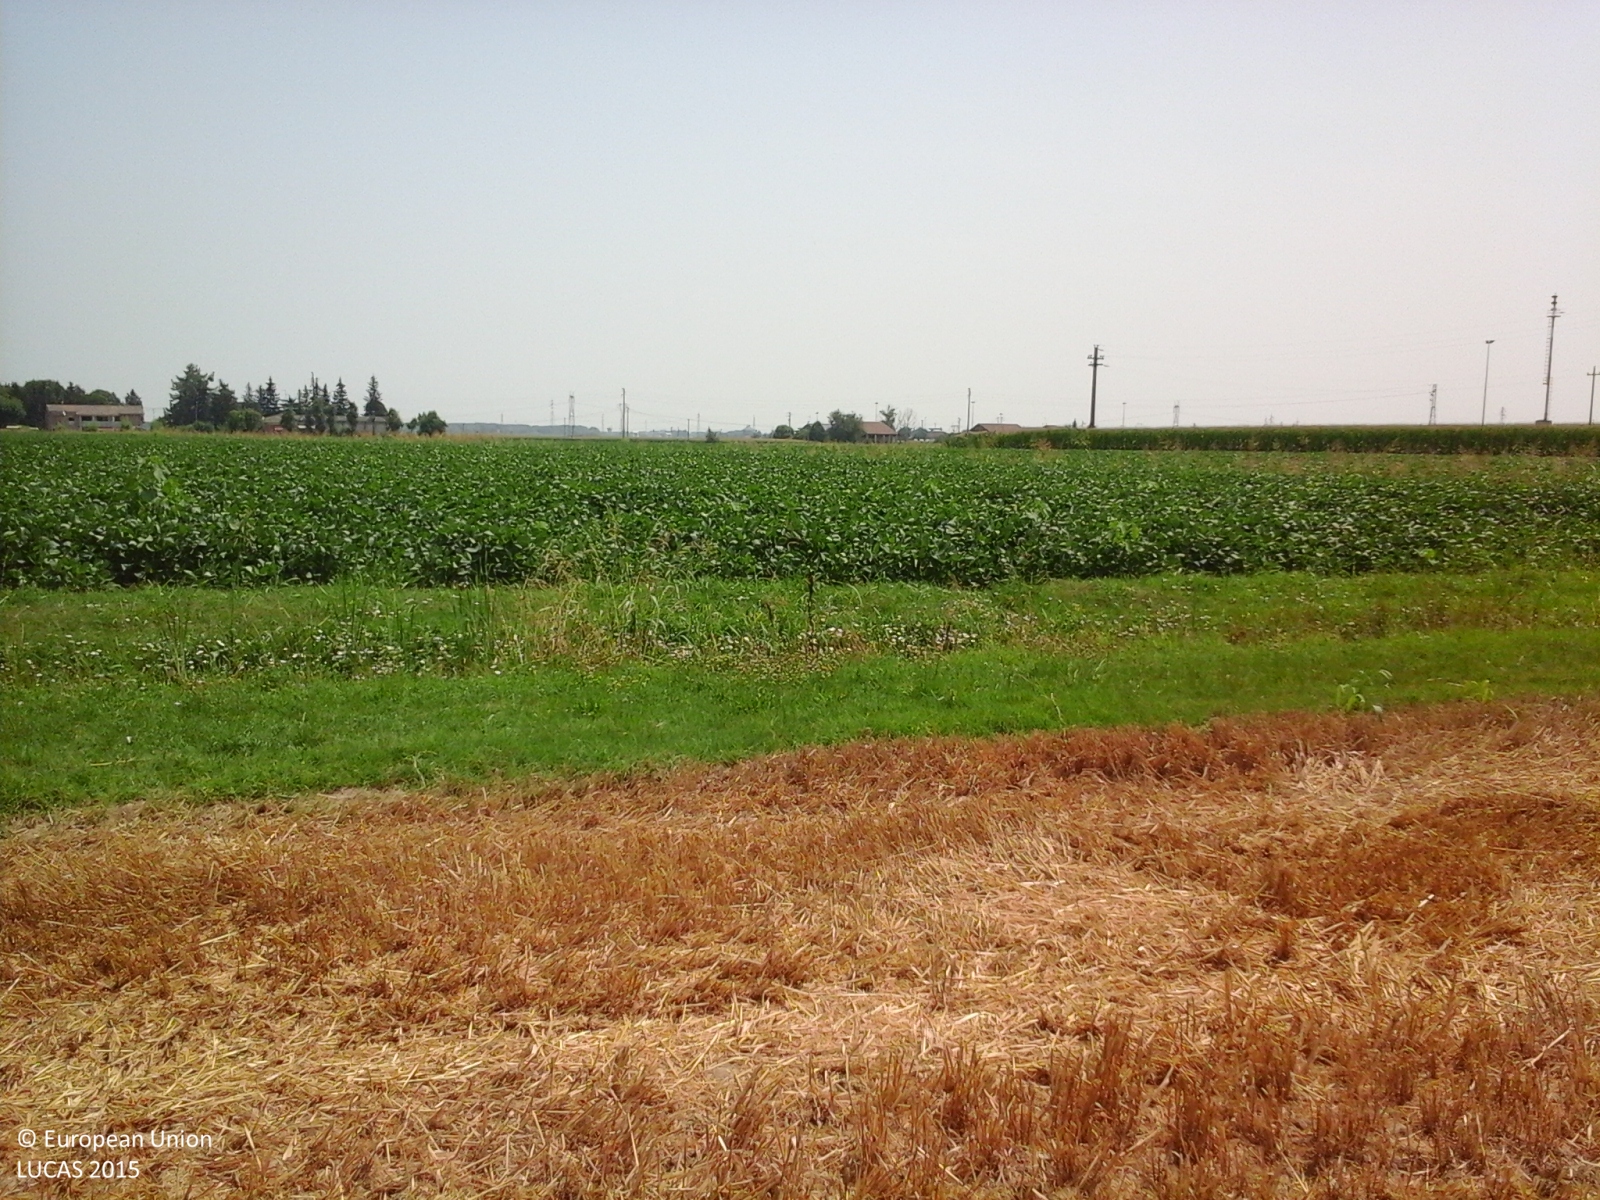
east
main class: Cropland
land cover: Common wheat
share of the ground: > 75 %
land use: Agriculture (excluding fallow land and kitchen gardens)
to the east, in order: Common wheat; Tracks; Grass margins; Ditches and canals; Tracks; Soya; Ditches and canals; Common wheat
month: July
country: IT
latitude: 44.8800
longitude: 11.5541
